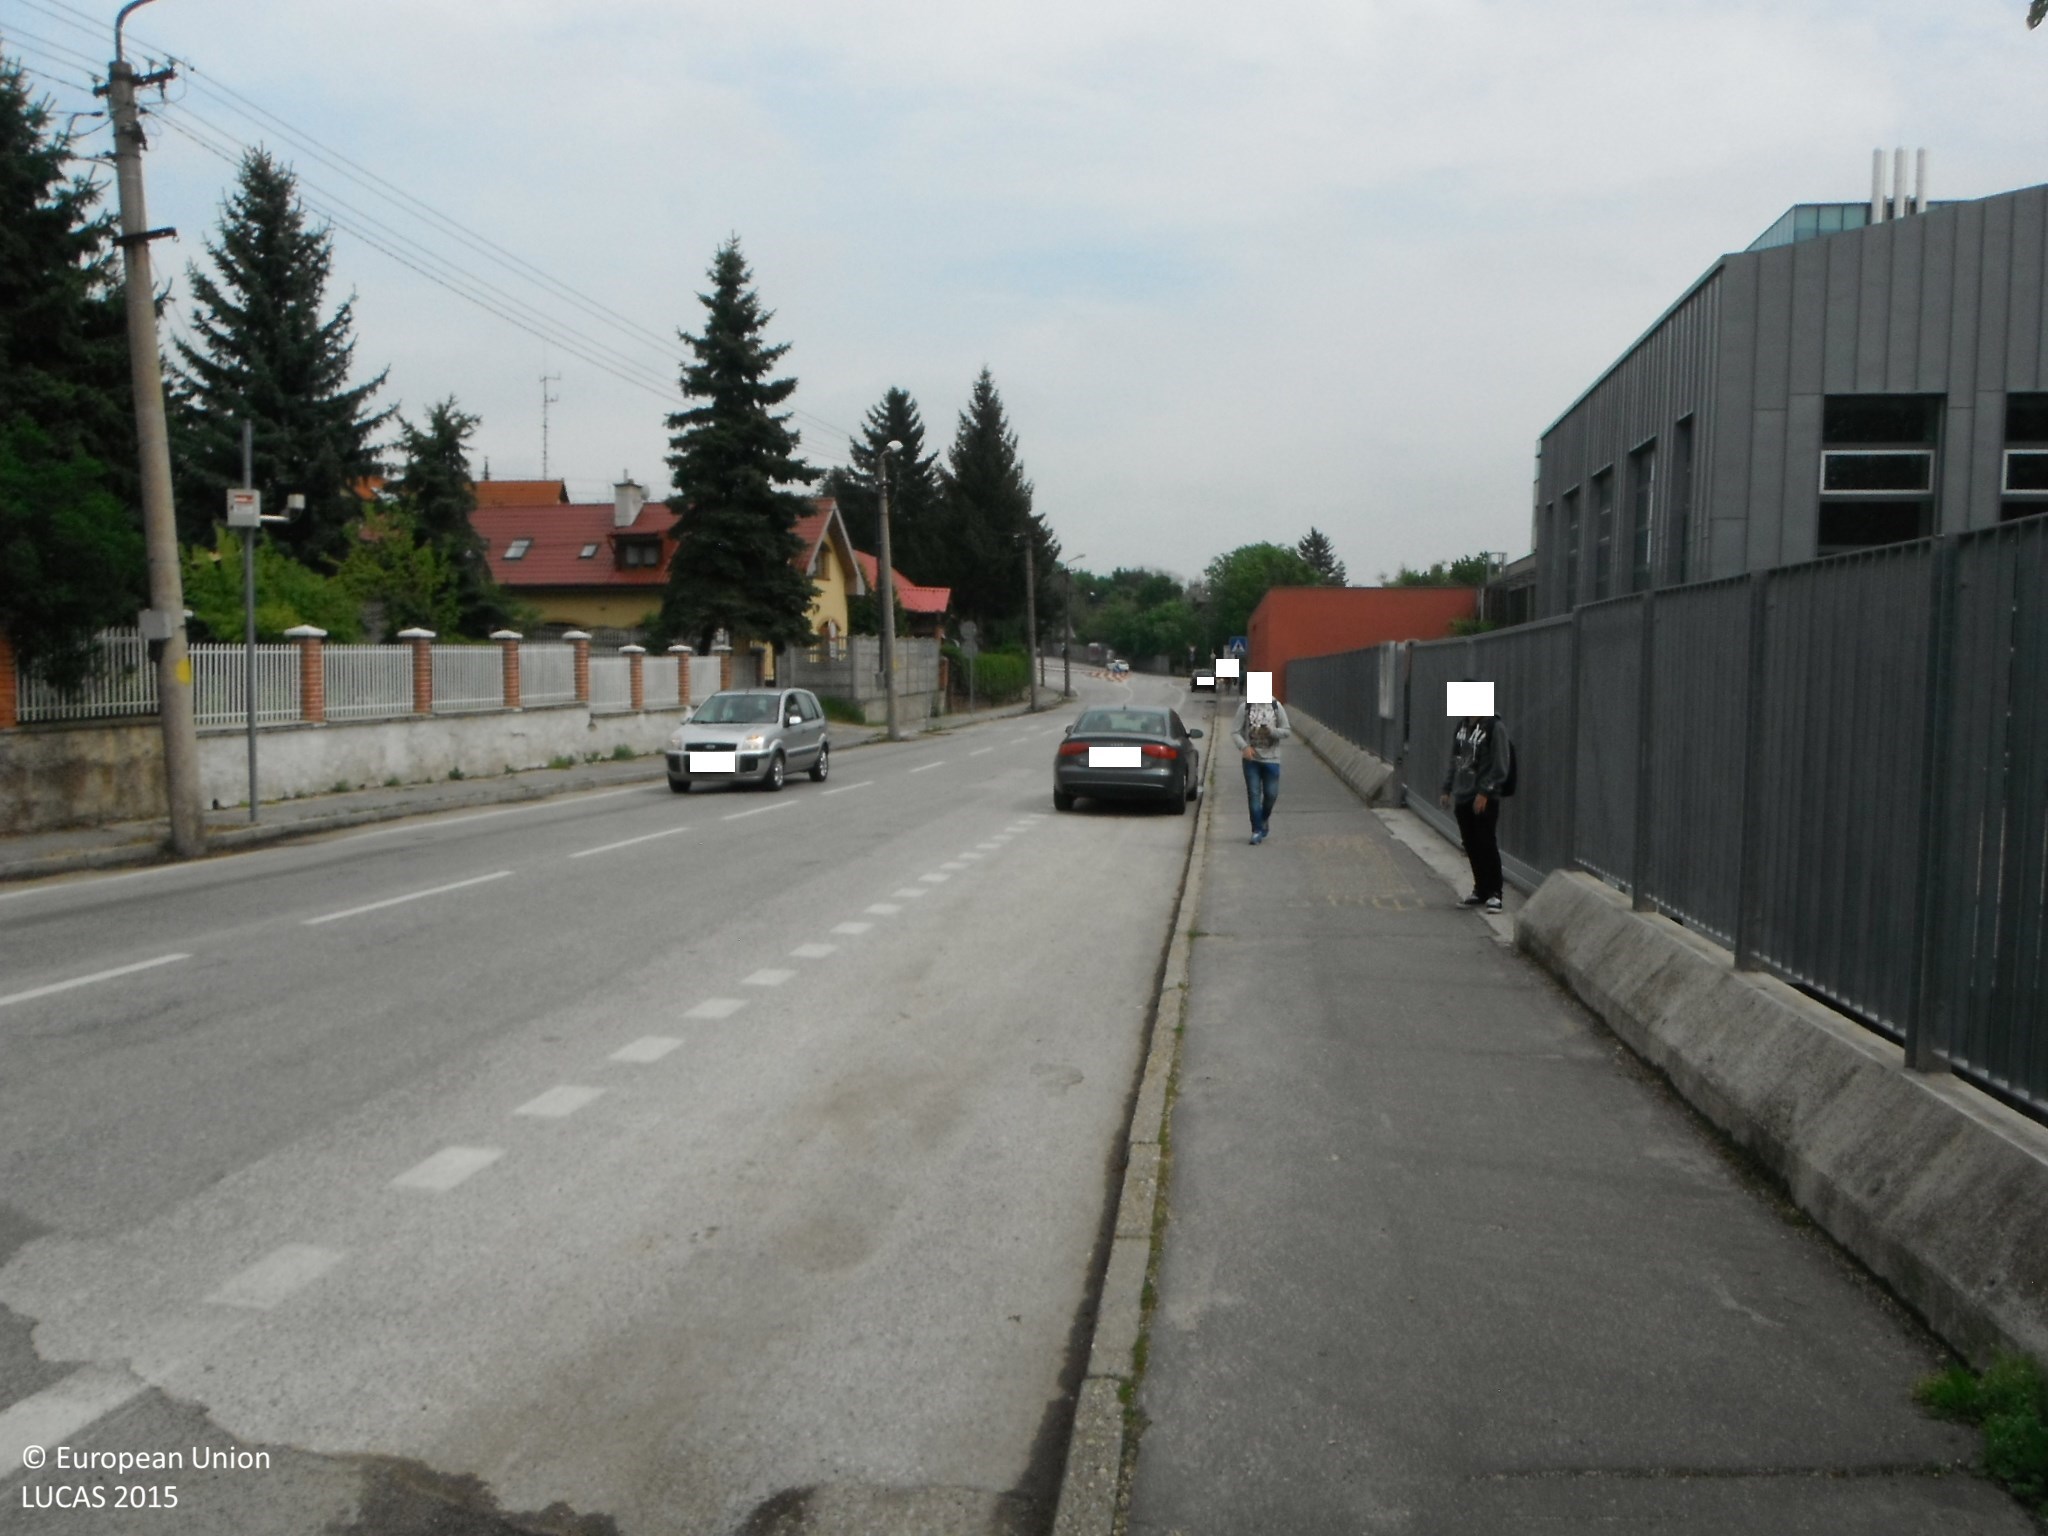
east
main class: Cropland
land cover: Other fruit trees and berries
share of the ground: > 75 %
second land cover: Grassland without tree/shrub cover
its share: > 75 %
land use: Kitchen garden
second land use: Amenities, museums, leisure
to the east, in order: Other fruit trees and berries; Grassland without tree/shrub cover; Artificial constructions in urban areas
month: May
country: SK
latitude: 48.3235
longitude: 18.0924
